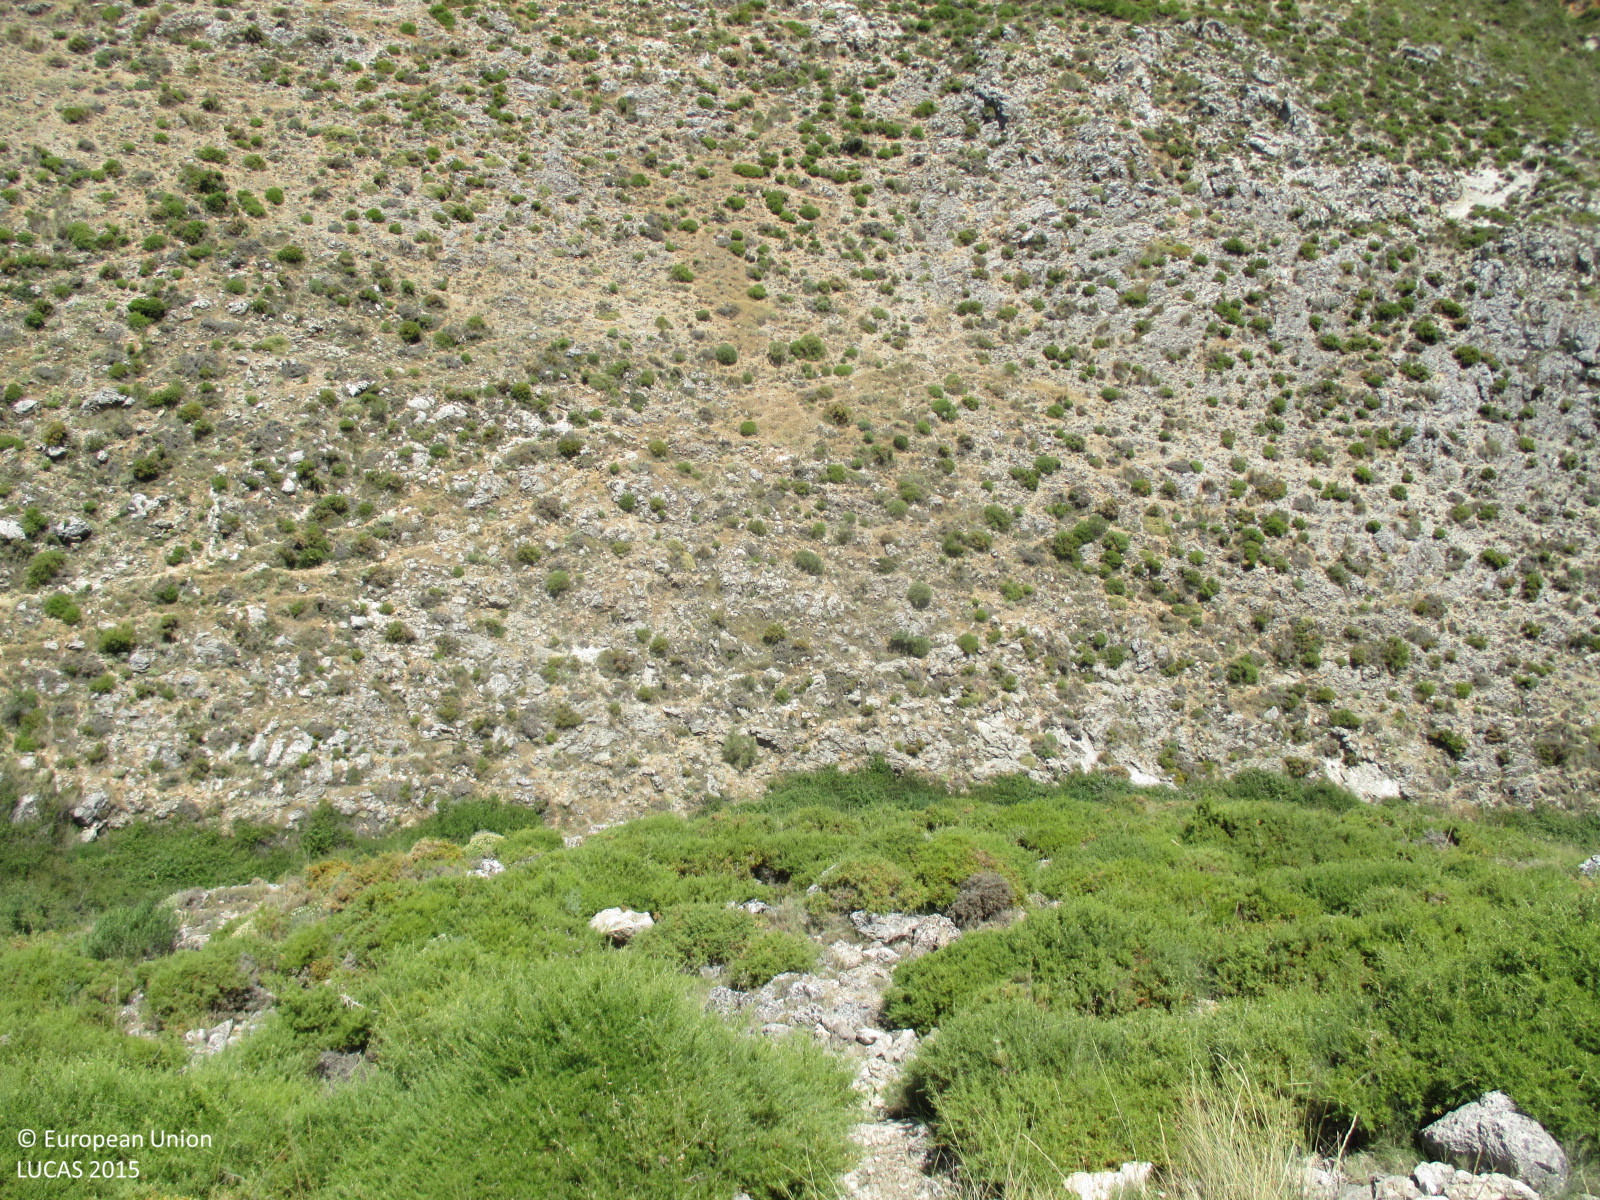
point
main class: Shrubland
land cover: Shrubland without tree cover
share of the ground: > 75 %
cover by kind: shrubs 60 %, herbaceous plants 40 %
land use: Semi-natural and natural areas not in use
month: June
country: ES
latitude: 37.4949
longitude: -3.7611
